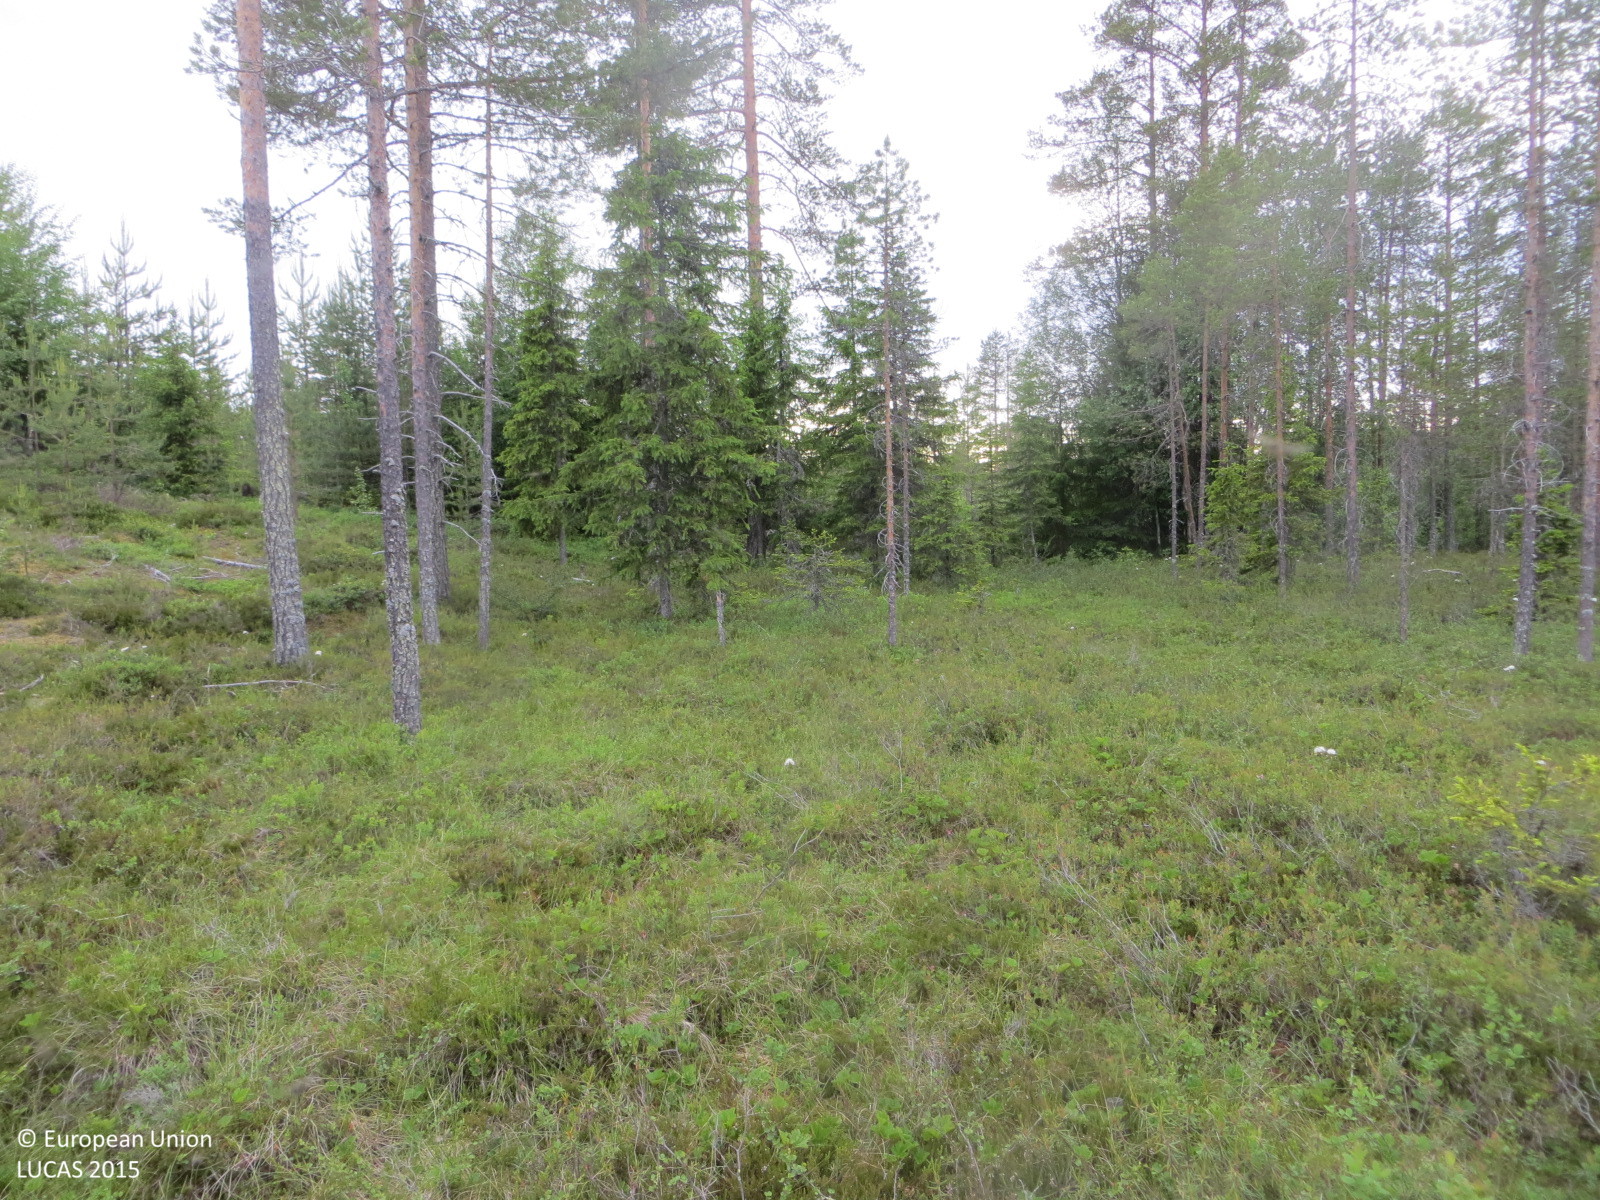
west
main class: Woodland
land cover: Pine dominated coniferous woodland
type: boreal forest
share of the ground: 25 - 50 %
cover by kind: shrubs 50 %, coniferous forest trees 40 %, lichens and mosses 10 %
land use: Forestry
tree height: > 5 m
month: June
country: FI
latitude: 65.4344
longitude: 26.1536
